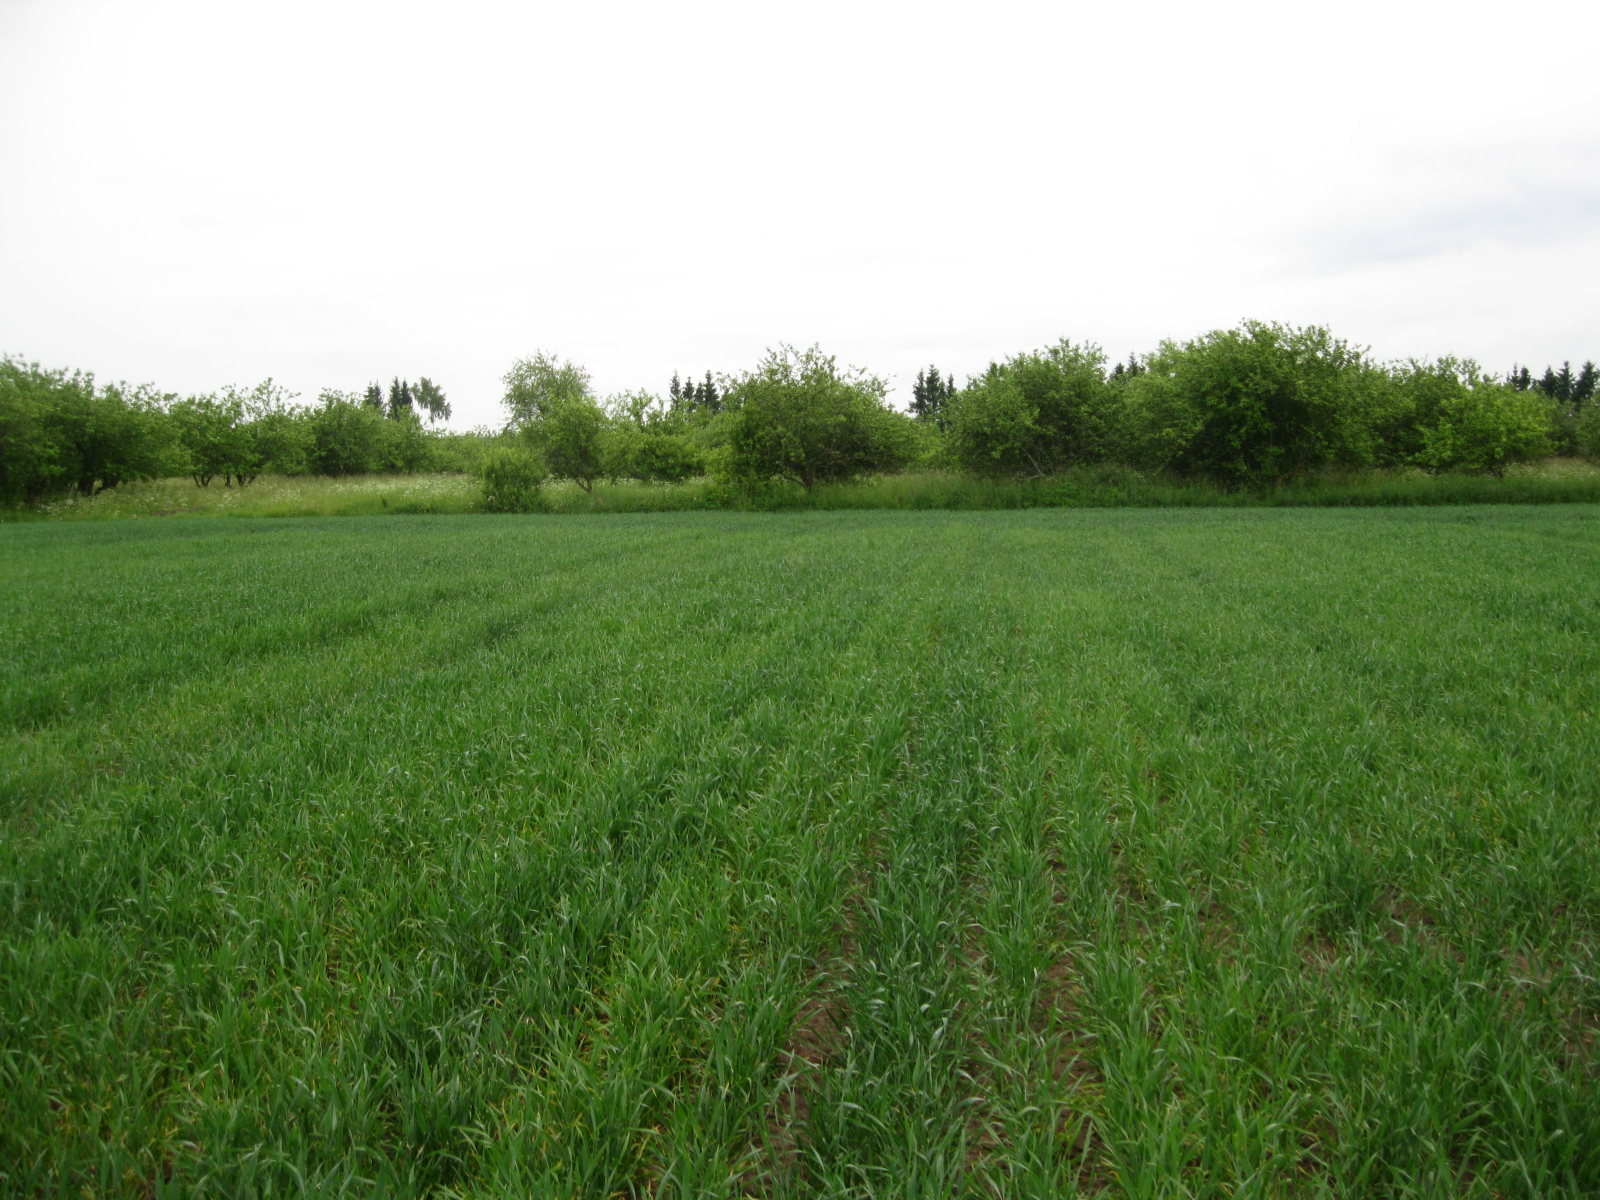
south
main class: Cropland
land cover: Common wheat
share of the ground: > 75 %
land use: Agriculture (excluding fallow land and kitchen gardens)
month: June
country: LT
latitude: 55.1684
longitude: 24.0797
